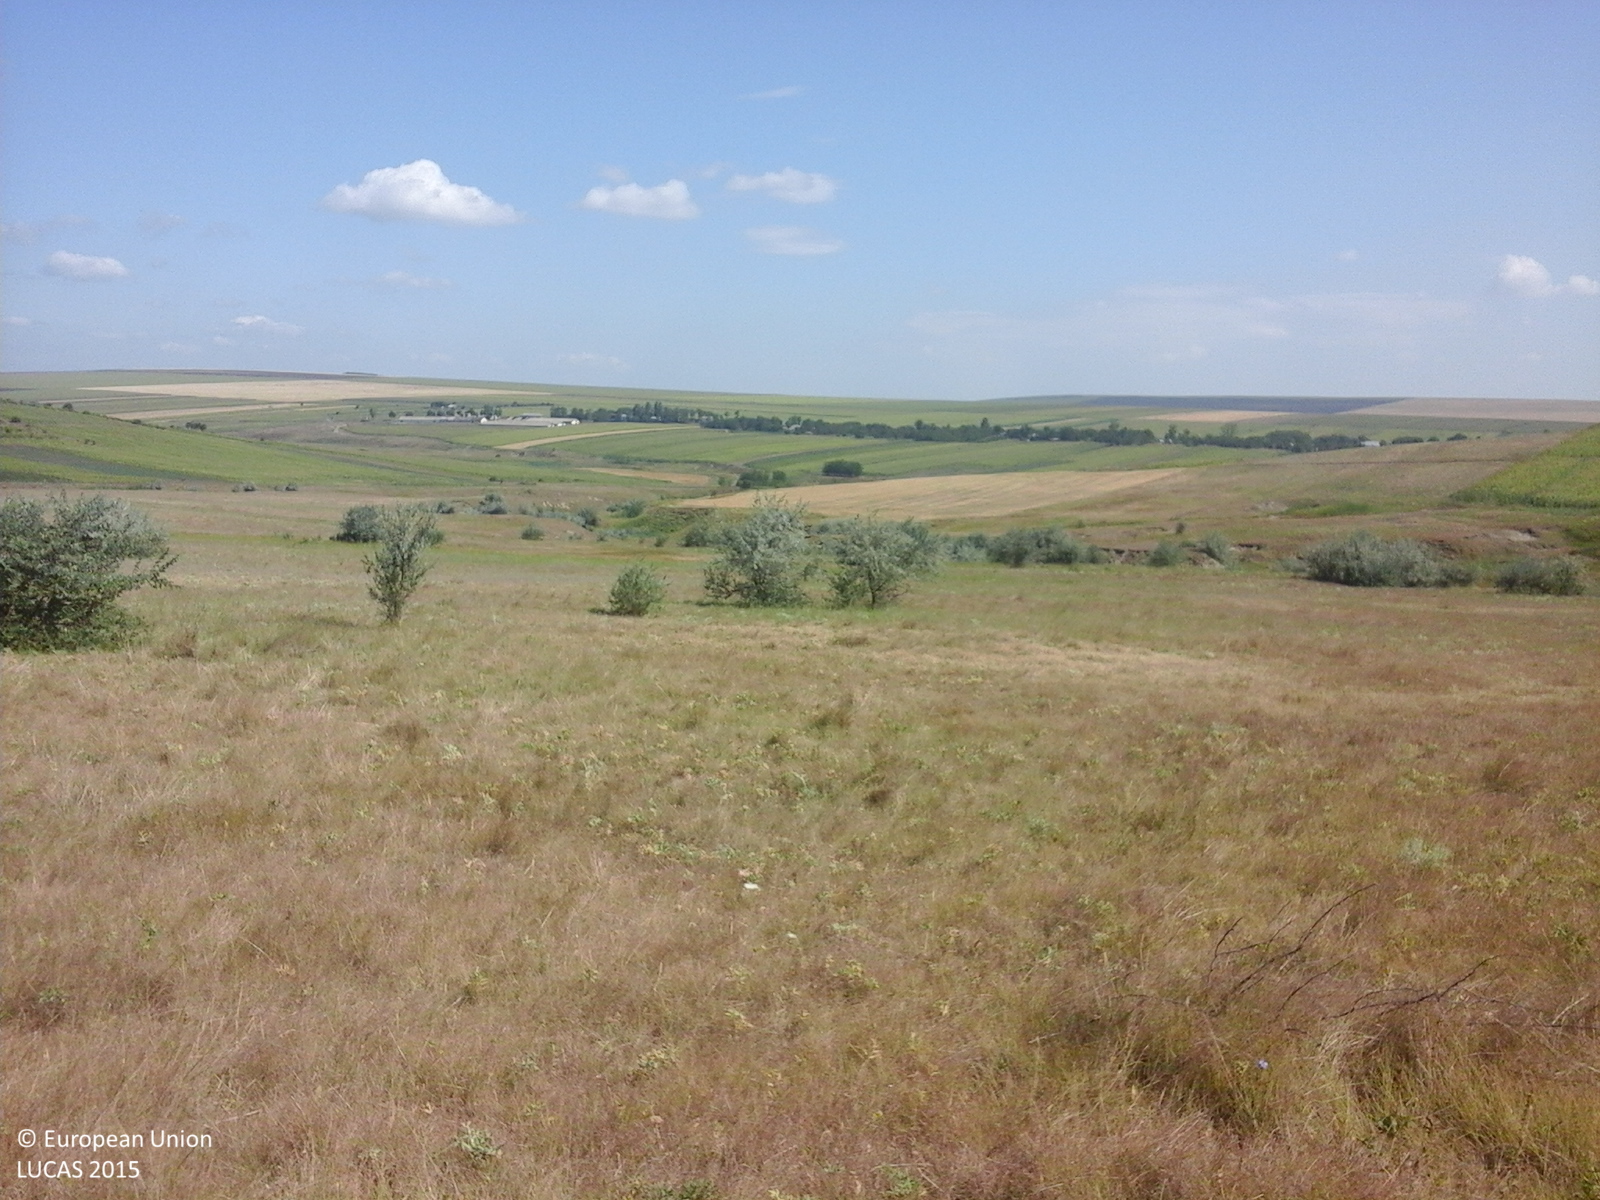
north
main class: Grassland
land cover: Grassland with sparse tree/shrub cover
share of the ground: > 75 %
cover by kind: herbaceous plants 85 %, shrubs 10 %, broadleaved forest trees 5 %
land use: Agriculture (excluding fallow land and kitchen gardens)
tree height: < 5 m
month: July
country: RO
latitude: 46.3965
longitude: 28.0892
